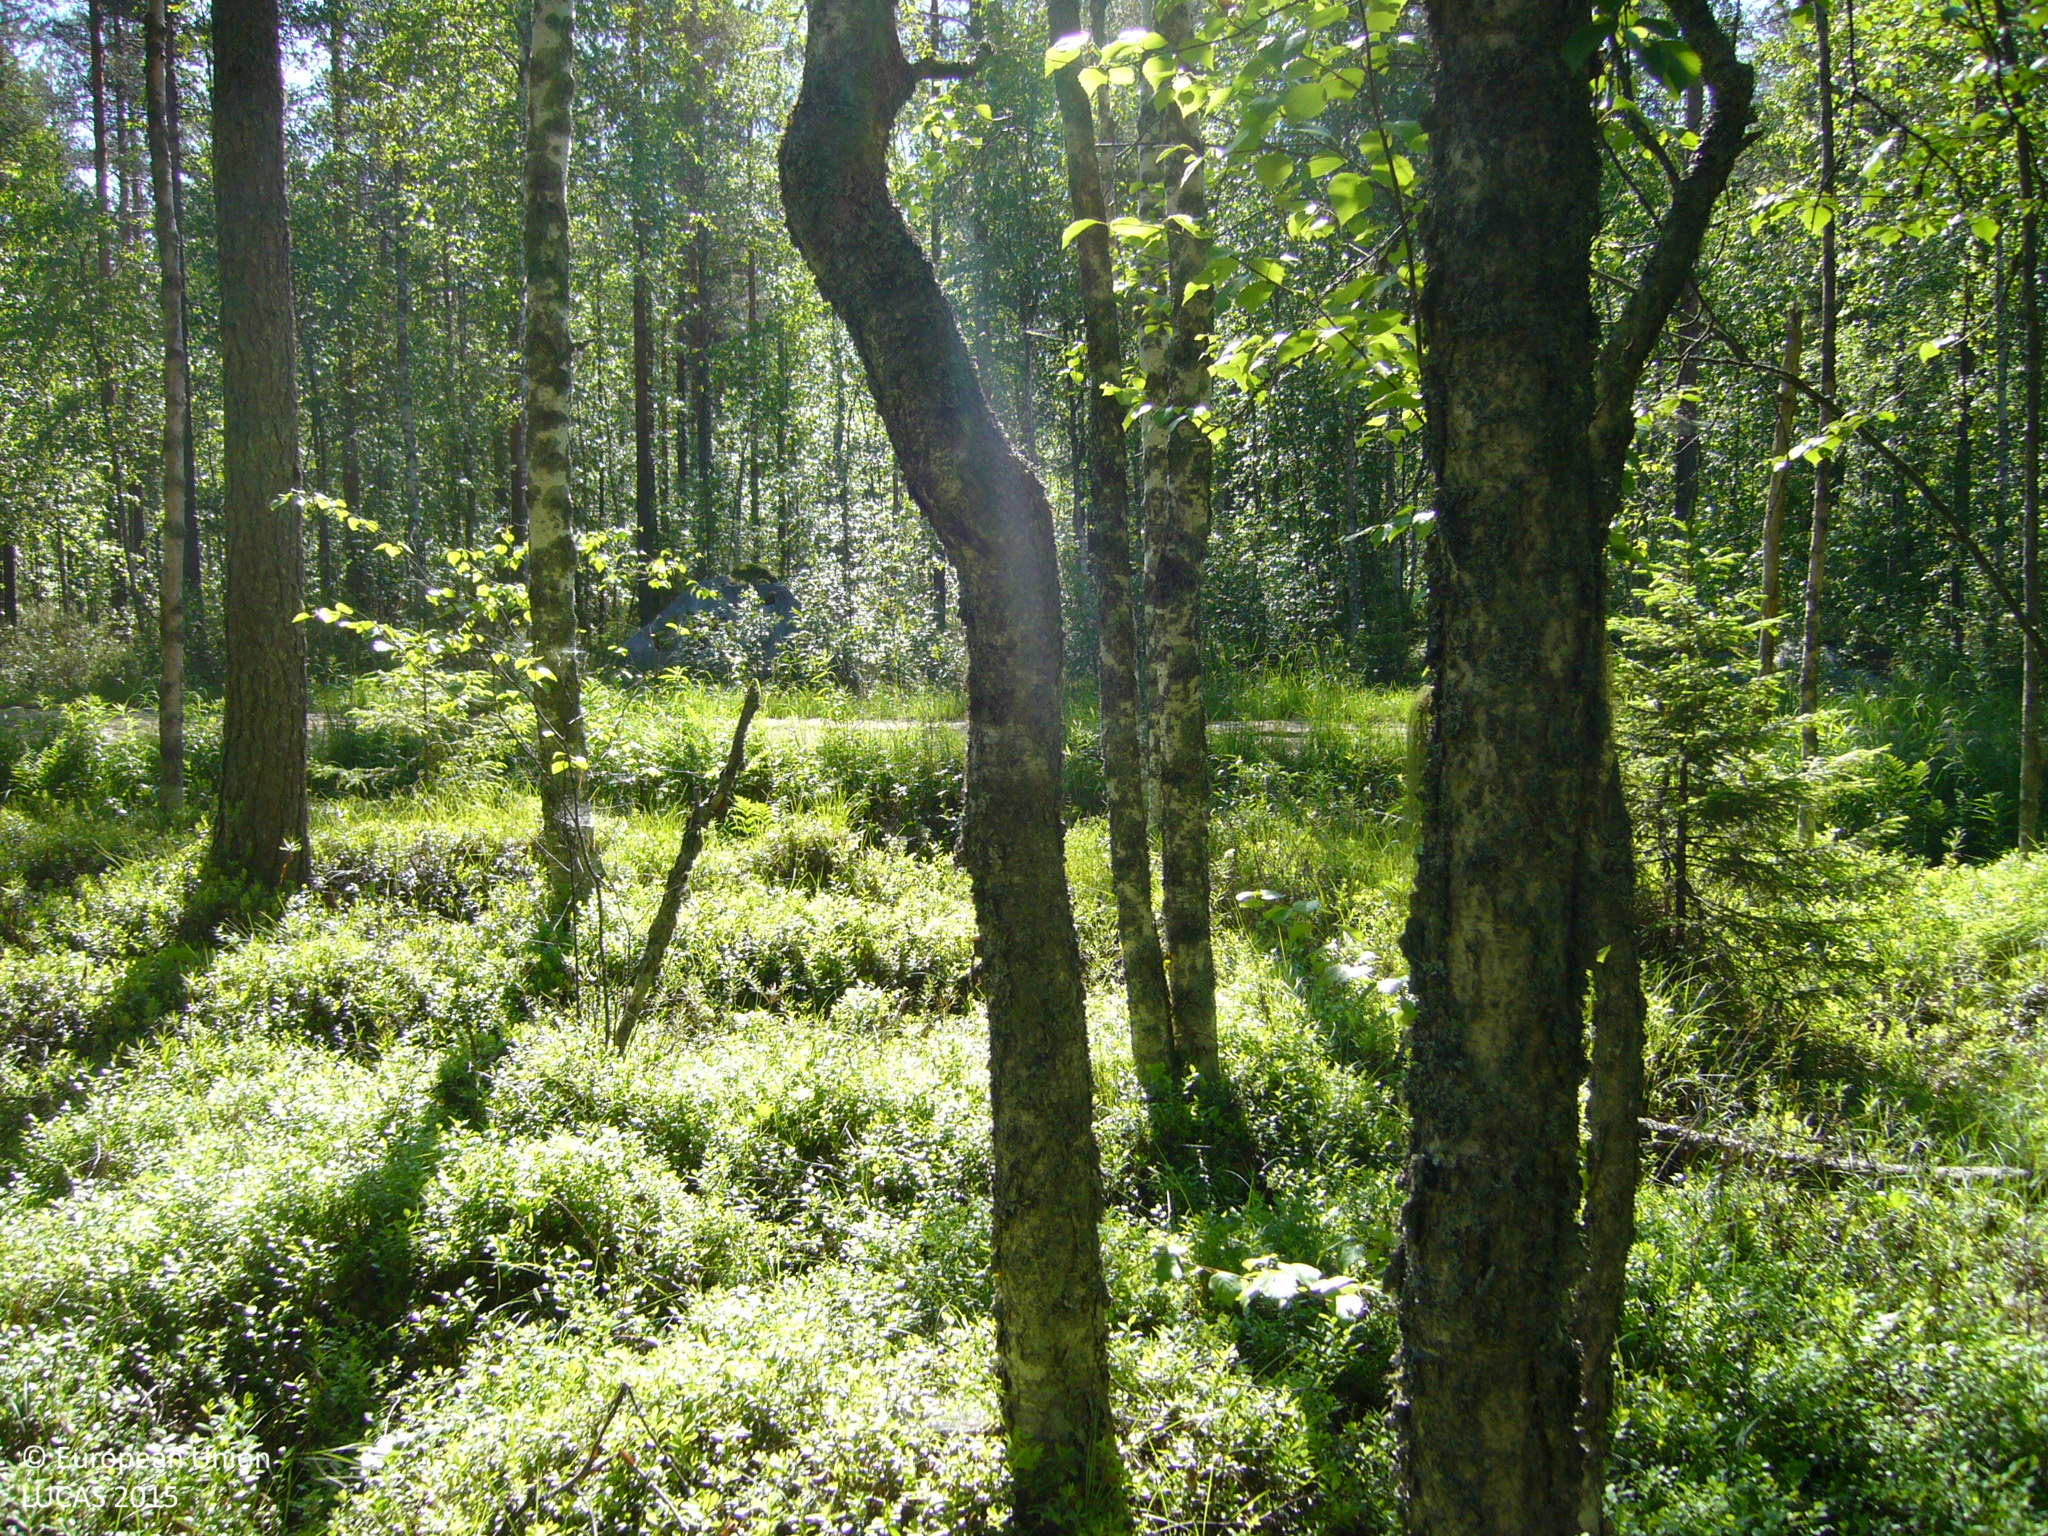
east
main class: Woodland
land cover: Pine dominated mixed woodland
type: boreal forest
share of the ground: > 75 %
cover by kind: coniferous forest trees 50 %, broadleaved forest trees 25 %, shrubs 25 %
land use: Forestry
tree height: > 5 m
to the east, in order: Pine dominated mixed woodland; Ditches and canals; Grass margins; Paved roads, cycling and walking lanes; Grass margins; Ditches and canals; Shruby margins; Pine dominated mixed woodland; Ditches and canals; Pine dominated mixed woodland; Ditches and canals; Pine dominated mixed woodland; Ditches and canals; Pine dominated mixed woodland; Pine dominated coniferous woodland; Ditches and canals; Pine dominated coniferous woodland
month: June
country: FI
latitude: 63.7722
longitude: 26.6150
